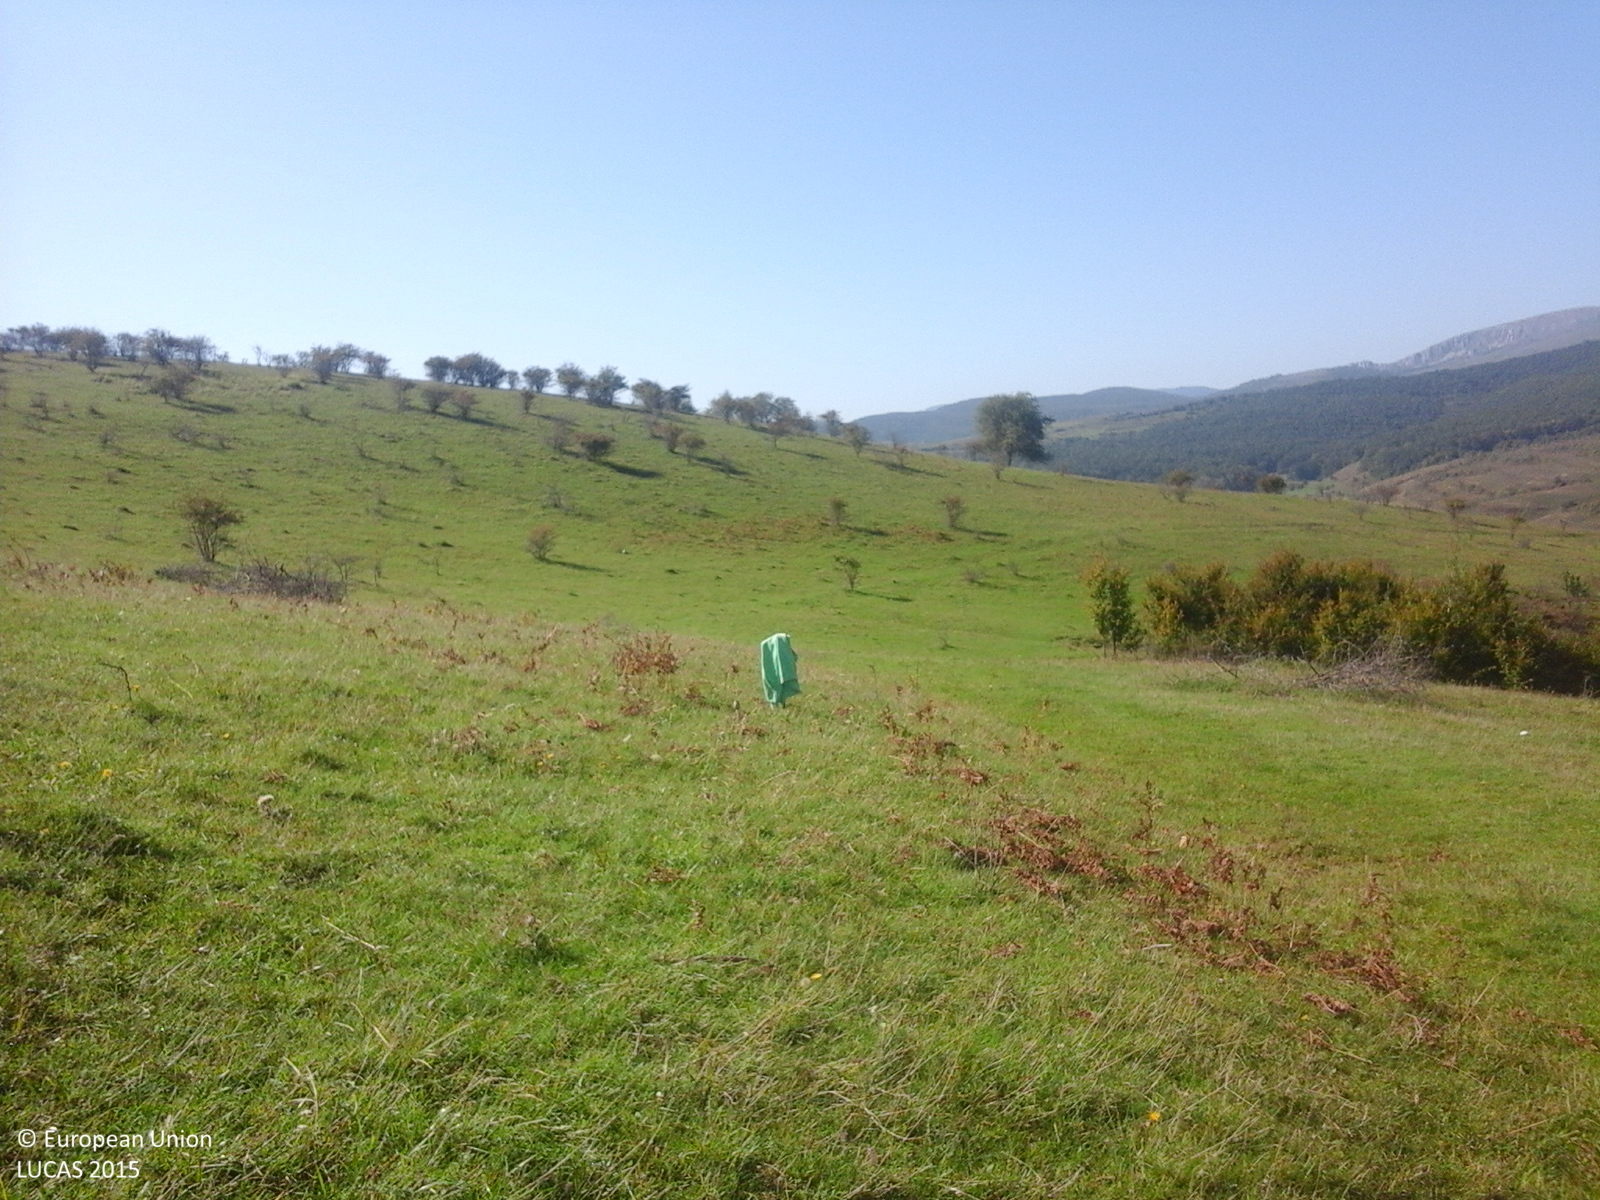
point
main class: Grassland
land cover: Grassland without tree/shrub cover
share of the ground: > 75 %
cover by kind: herbaceous plants 100 %
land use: Agriculture (excluding fallow land and kitchen gardens)
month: October
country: RO
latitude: 46.4151
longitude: 23.6921
